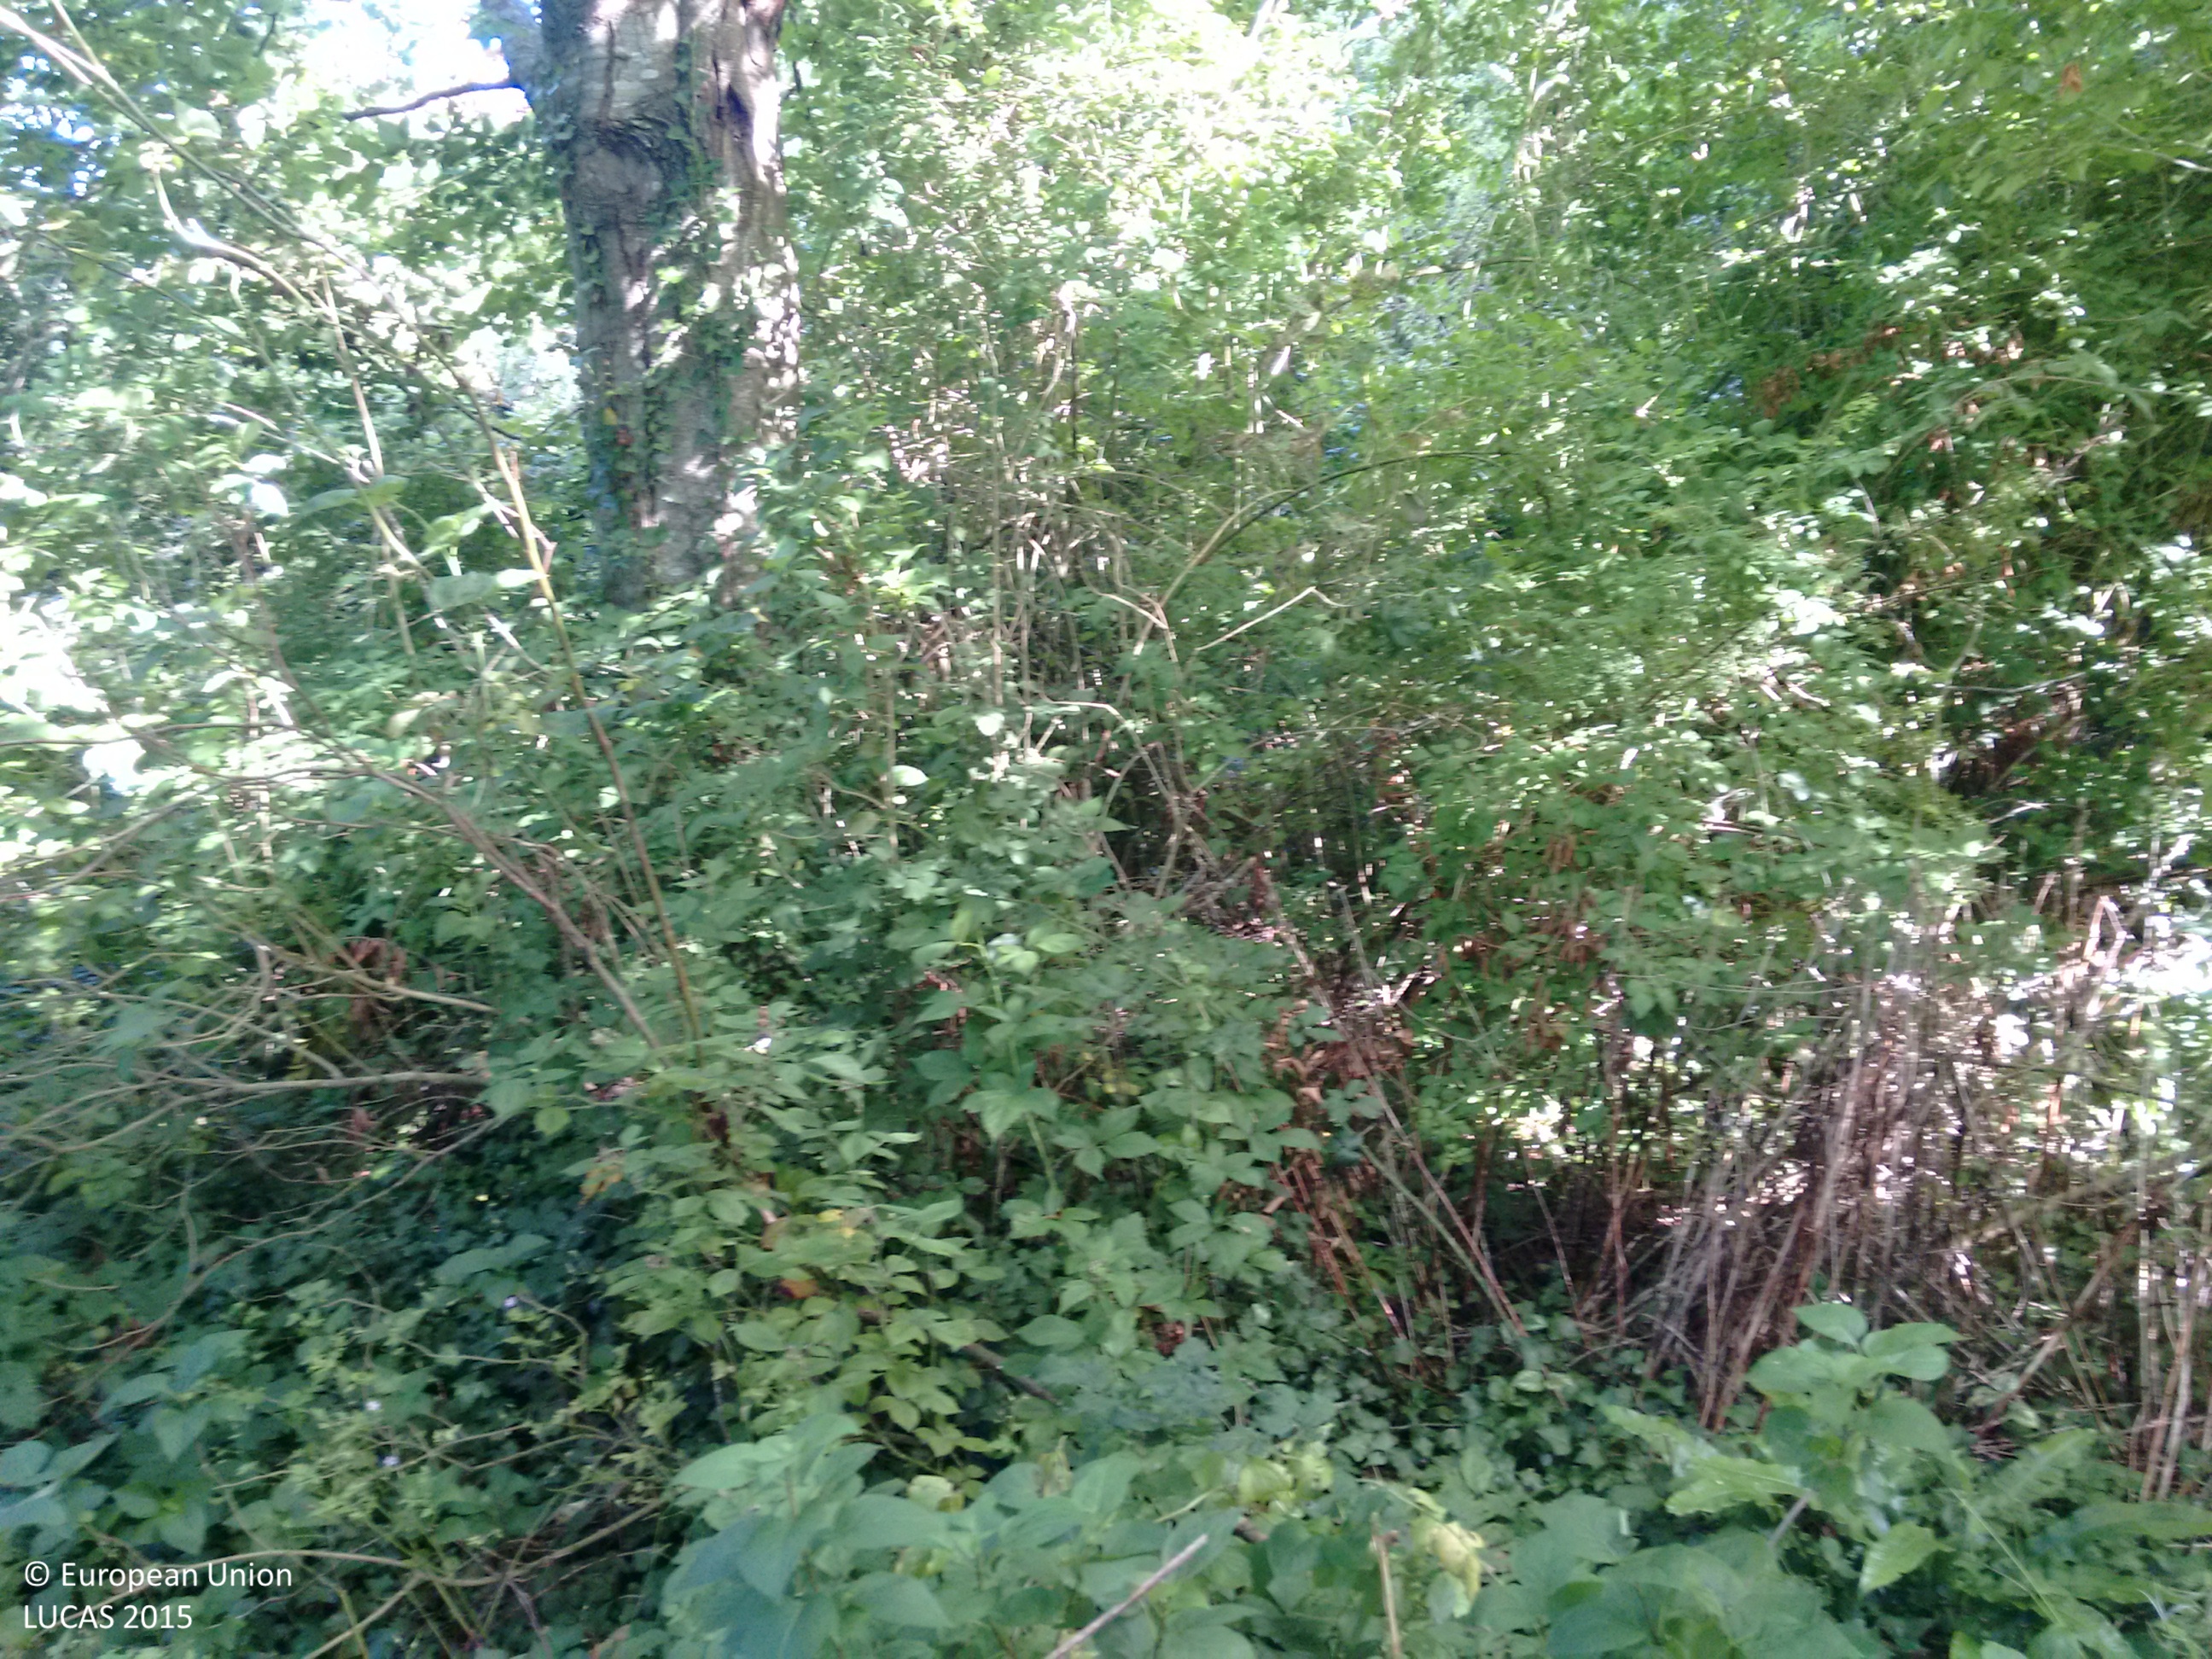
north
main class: Woodland
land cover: Broadleaved woodland
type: mesophytic deciduous forest
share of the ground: > 75 %
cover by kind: broadleaved forest trees 100 %
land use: Residential
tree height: > 5 m
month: August
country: GB
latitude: 50.1695
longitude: -5.4284
